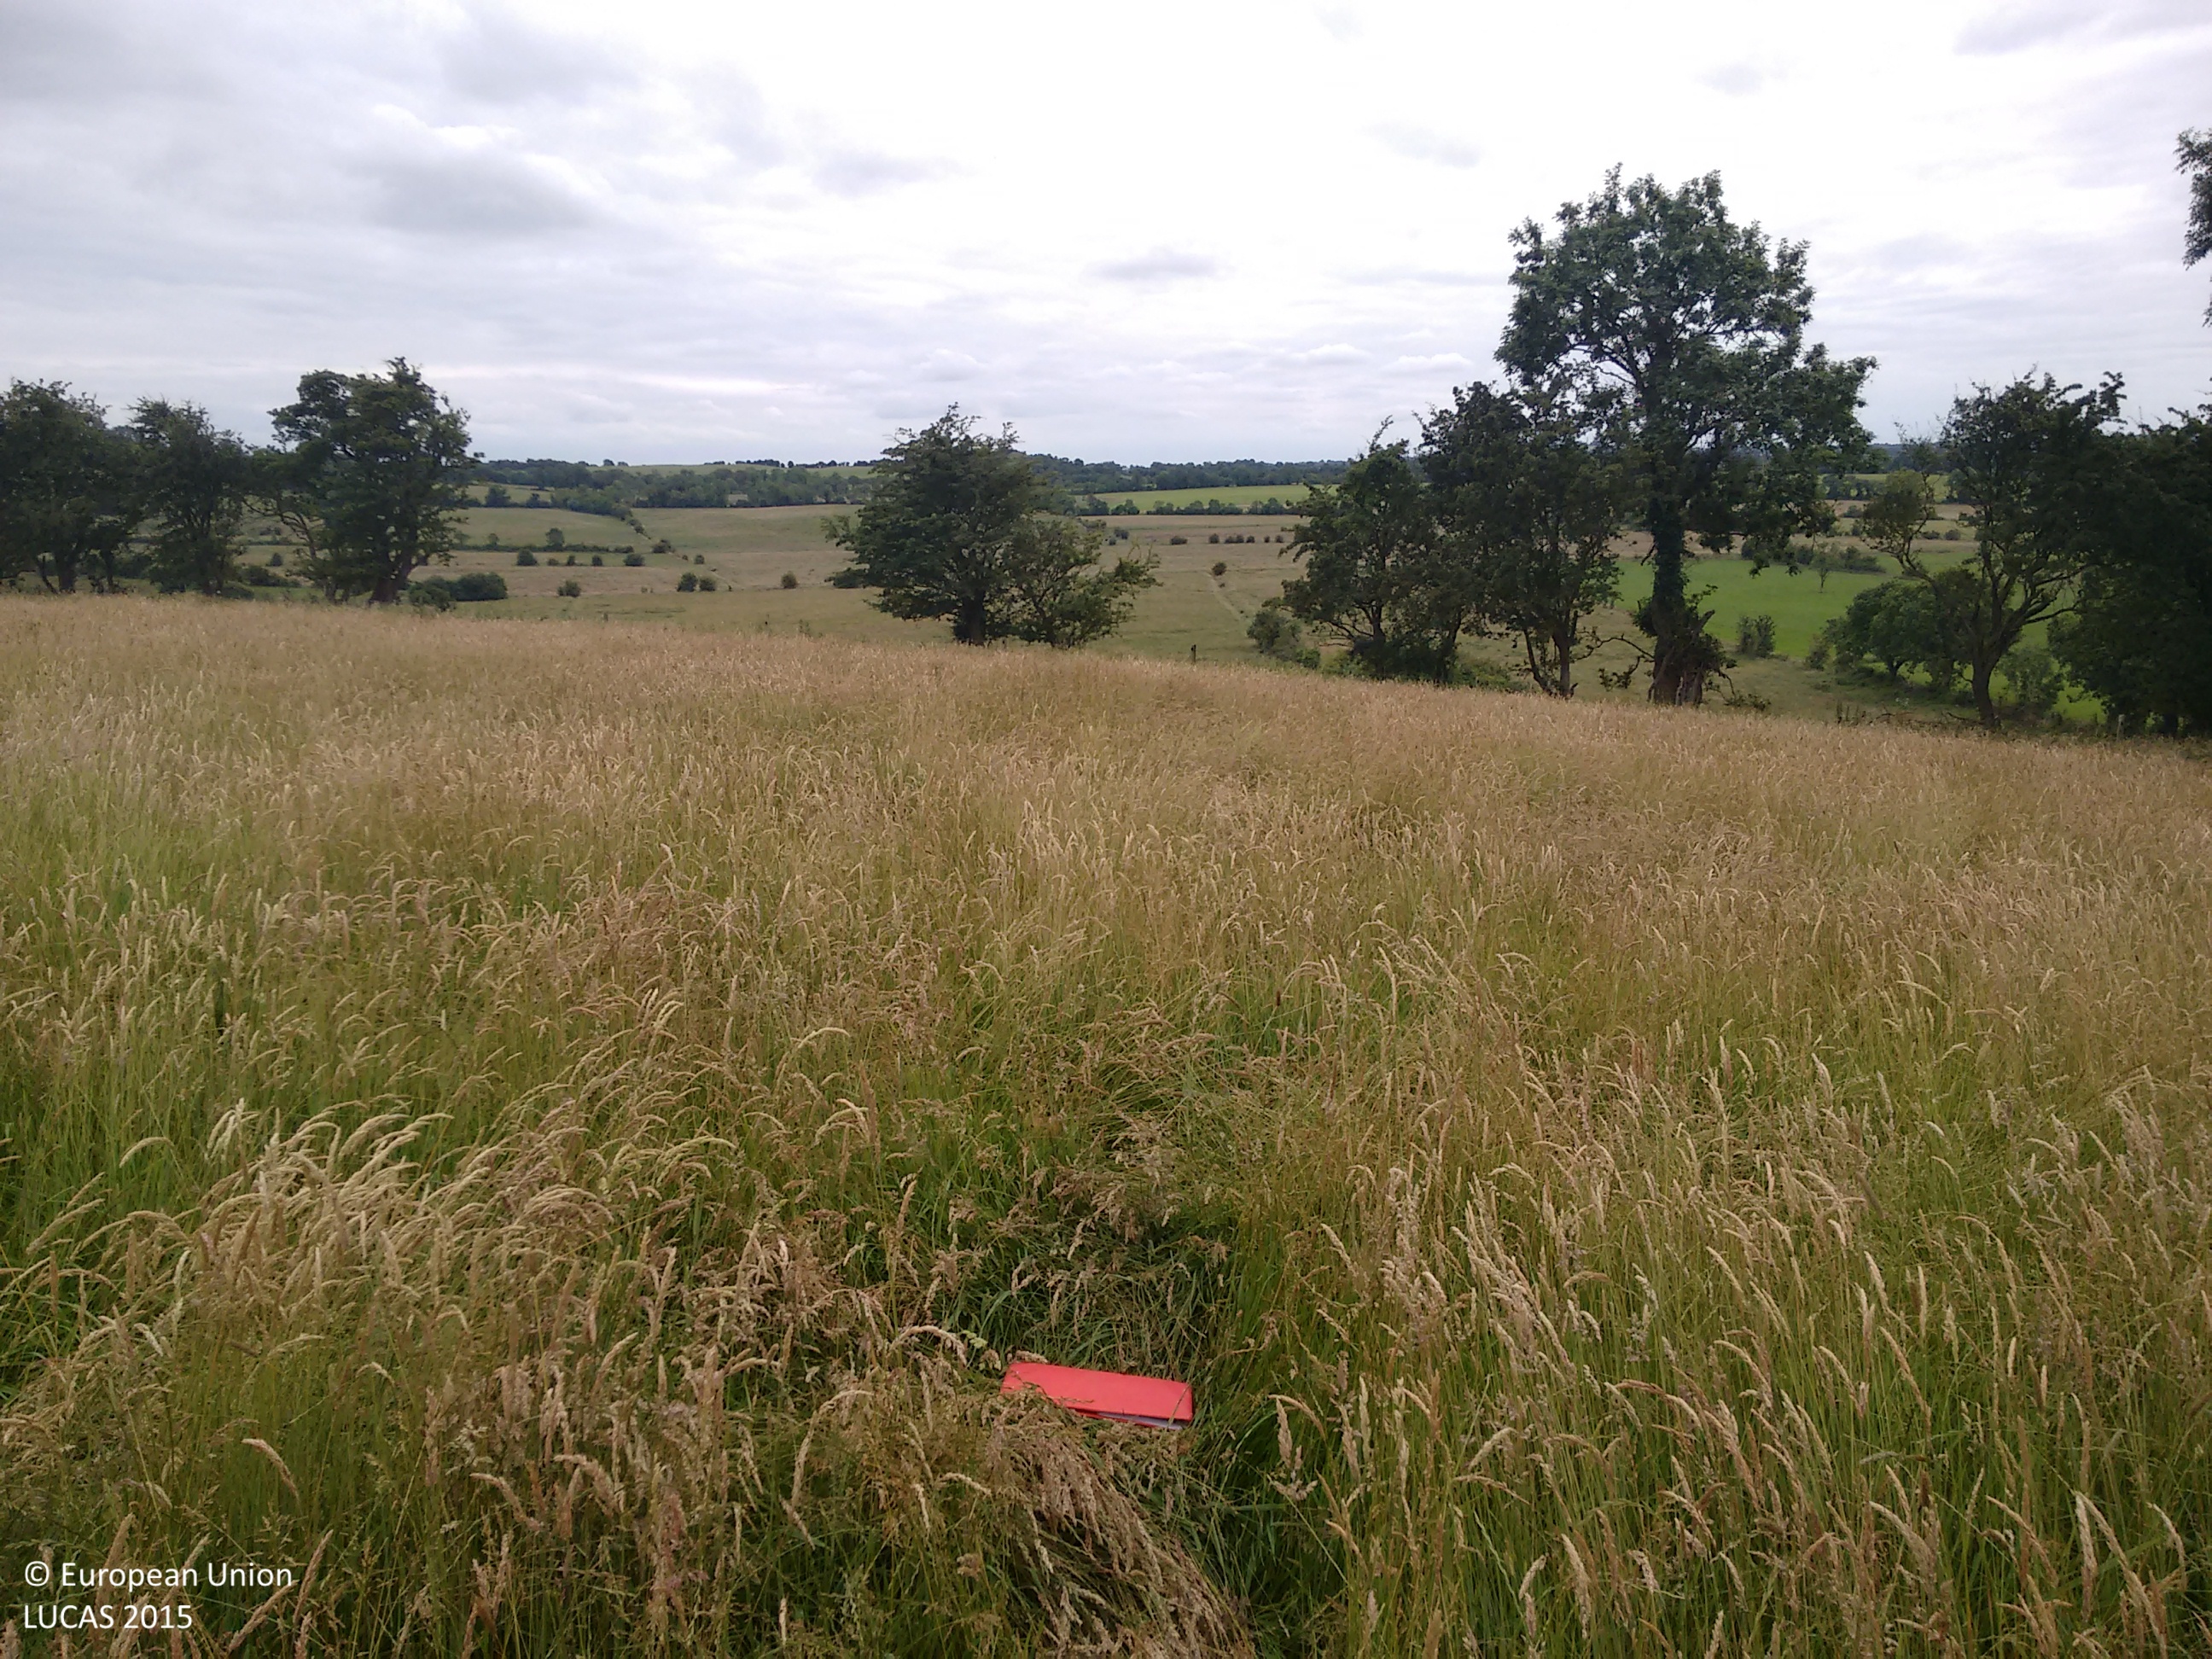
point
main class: Grassland
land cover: Grassland without tree/shrub cover
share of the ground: > 75 %
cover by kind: herbaceous plants 100 %
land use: Agriculture (excluding fallow land and kitchen gardens)
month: July
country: IE
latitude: 53.4678
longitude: -7.6837
